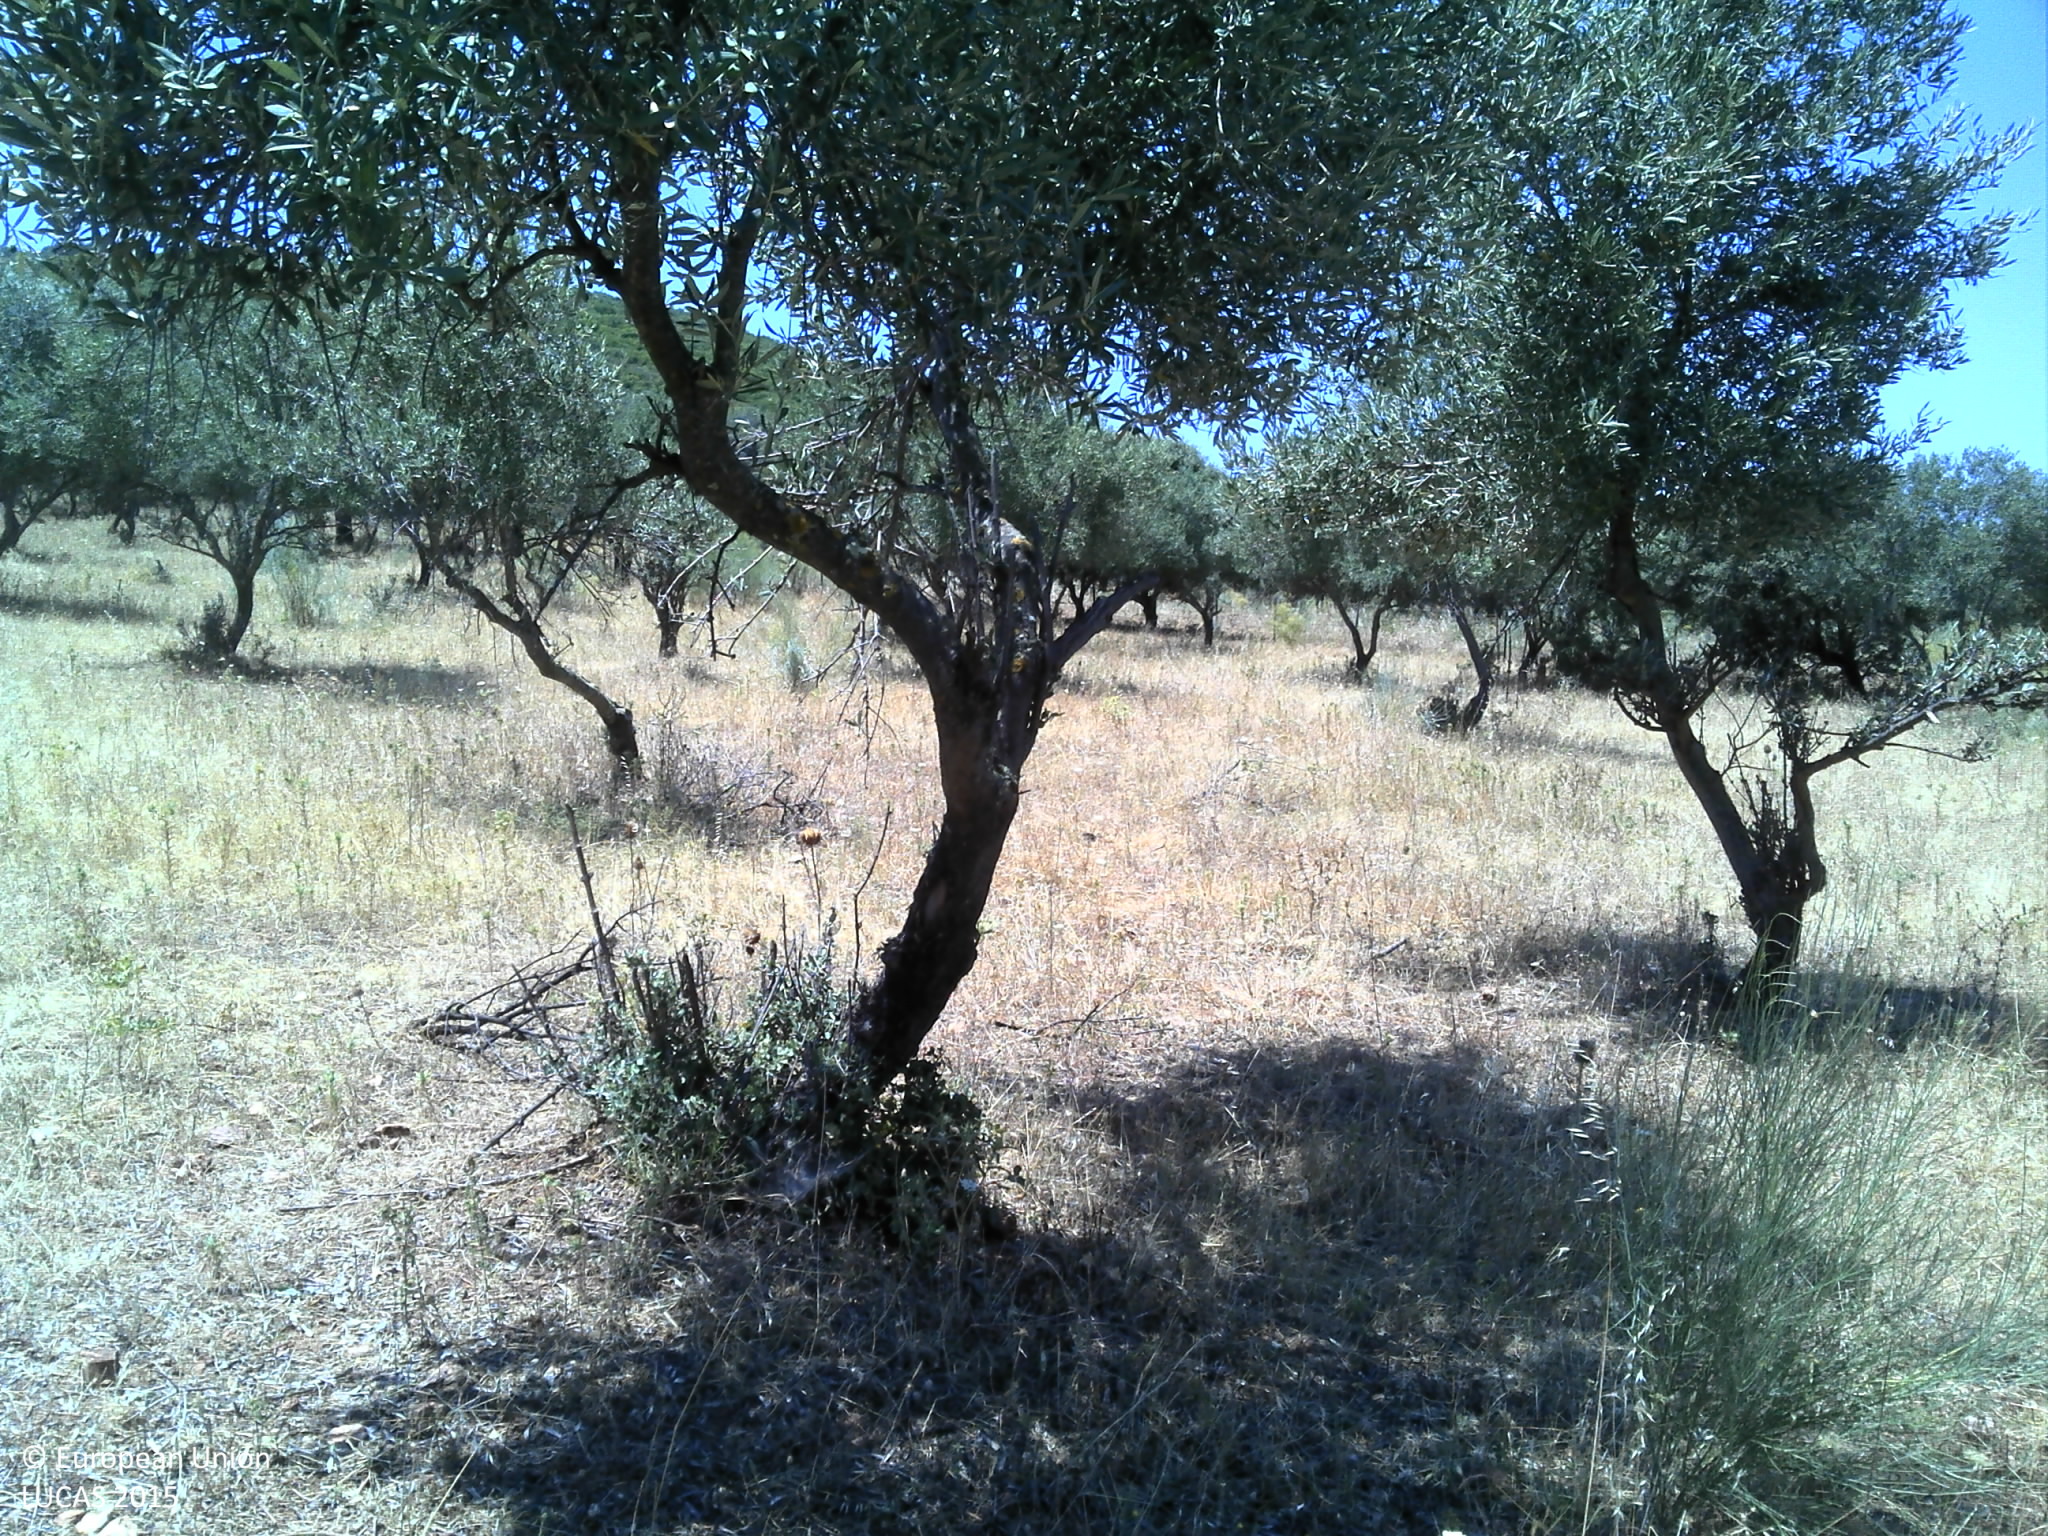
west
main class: Cropland
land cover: Olive groves
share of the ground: 25 - 50 %
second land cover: Grassland without tree/shrub cover
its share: 50 - 75 %
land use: Agriculture (excluding fallow land and kitchen gardens)
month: June
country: PT
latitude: 38.0519
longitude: -7.3036
